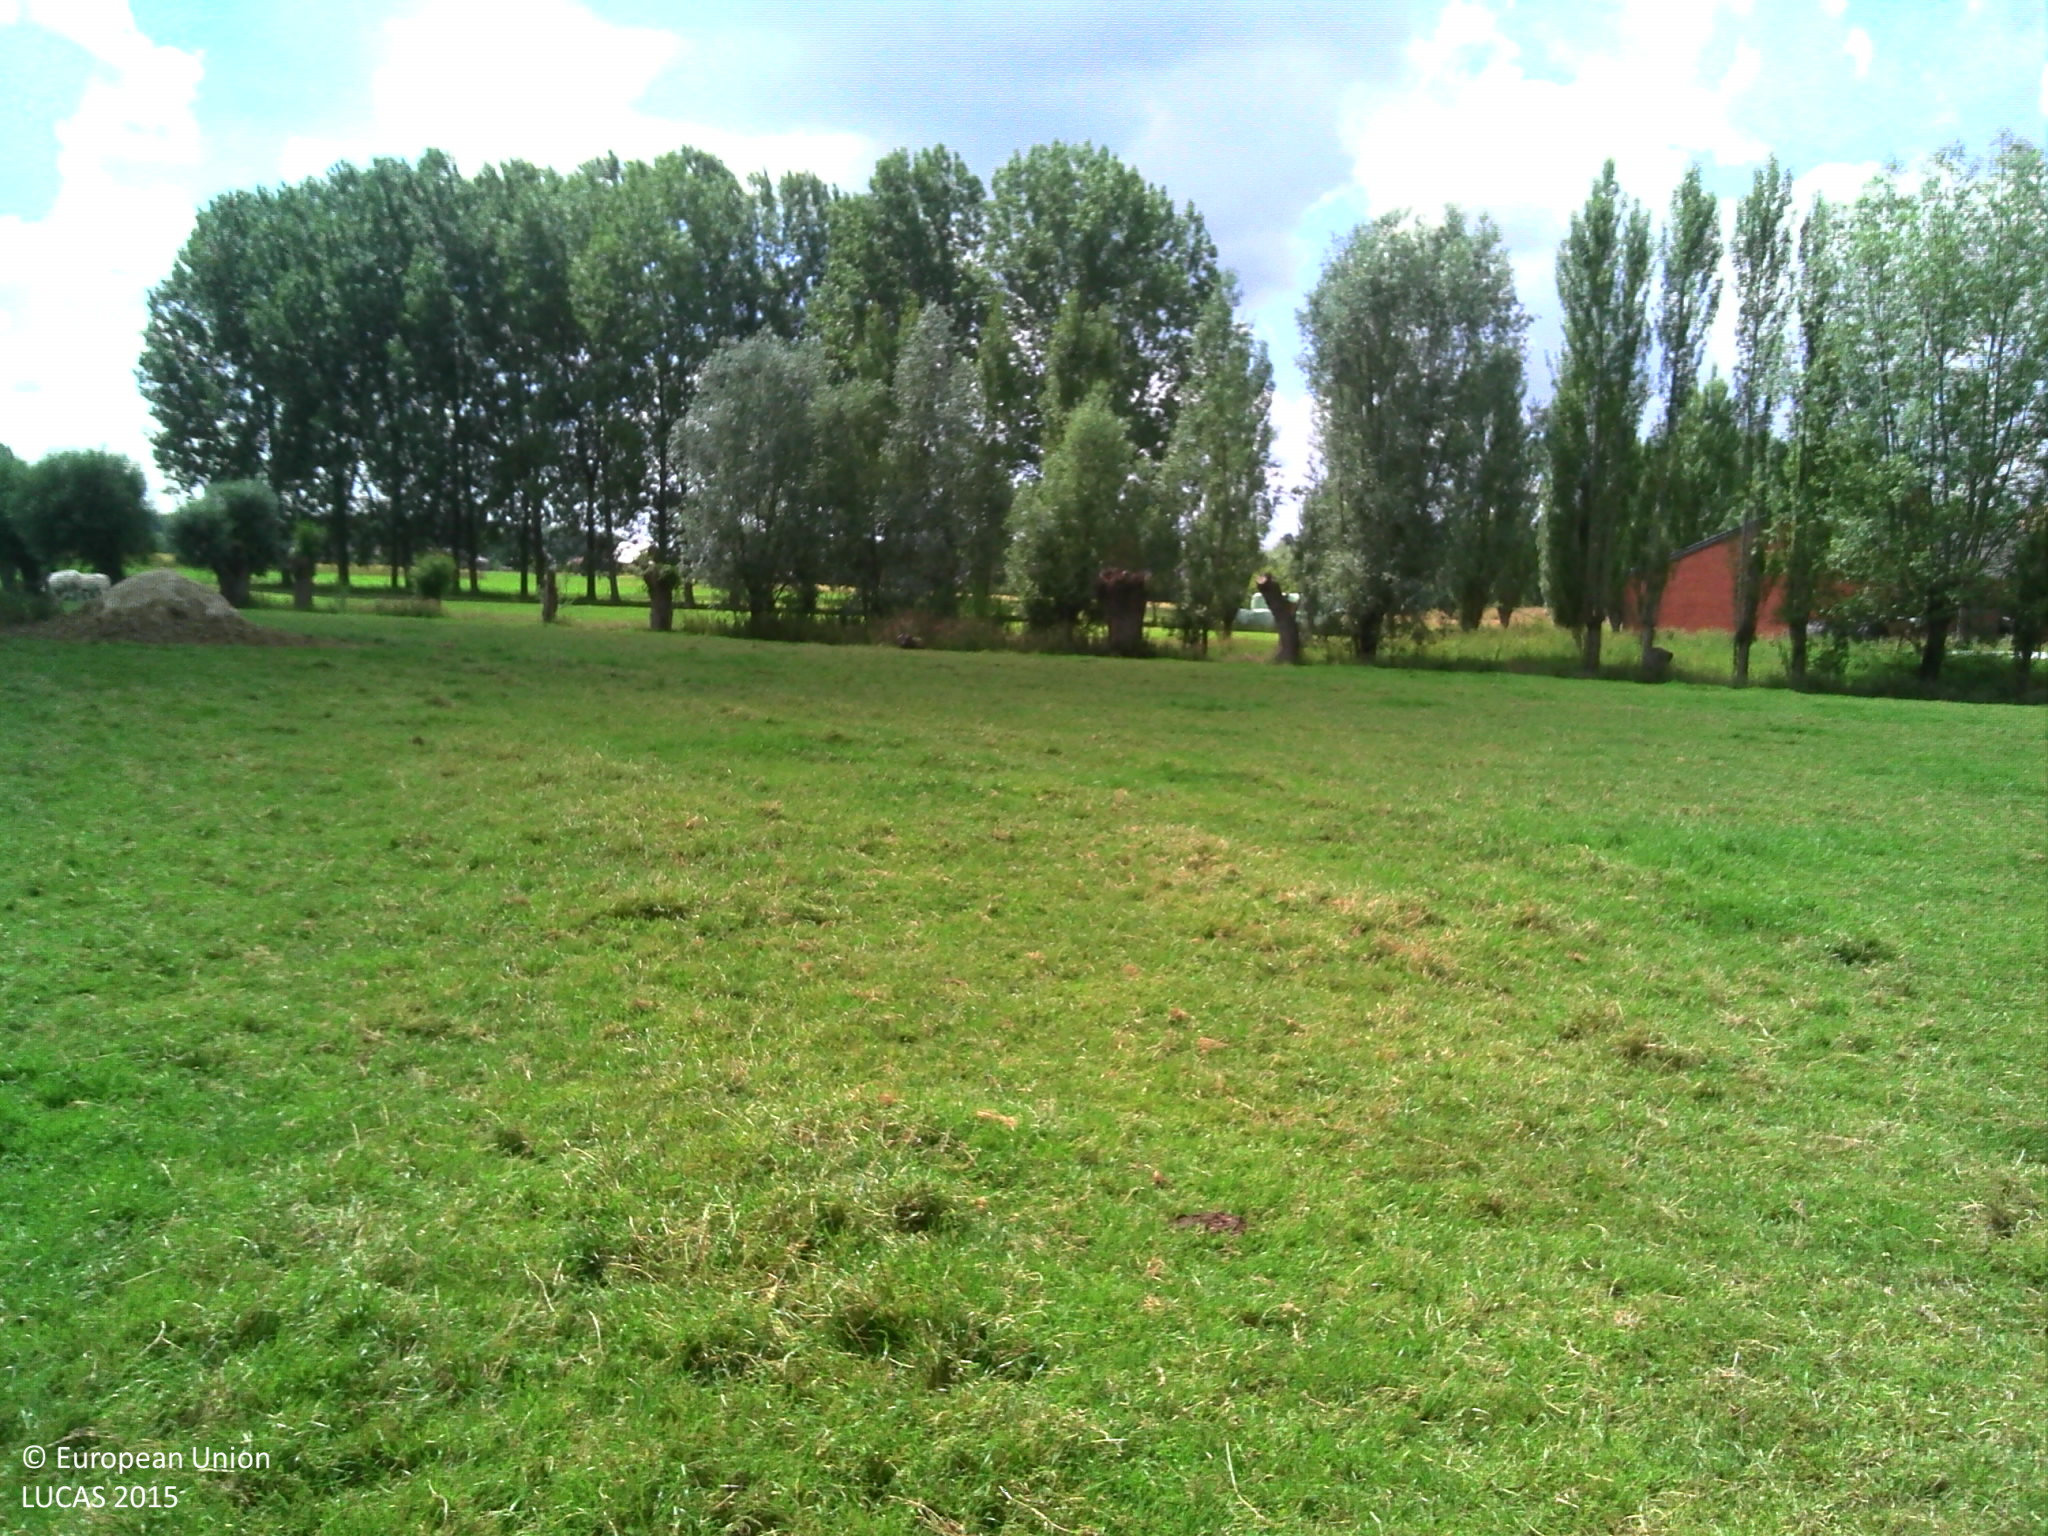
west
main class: Grassland
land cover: Grassland without tree/shrub cover
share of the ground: > 75 %
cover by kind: herbaceous plants 100 %
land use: Agriculture (excluding fallow land and kitchen gardens)
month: June
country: BE
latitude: 51.0678
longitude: 3.5850
